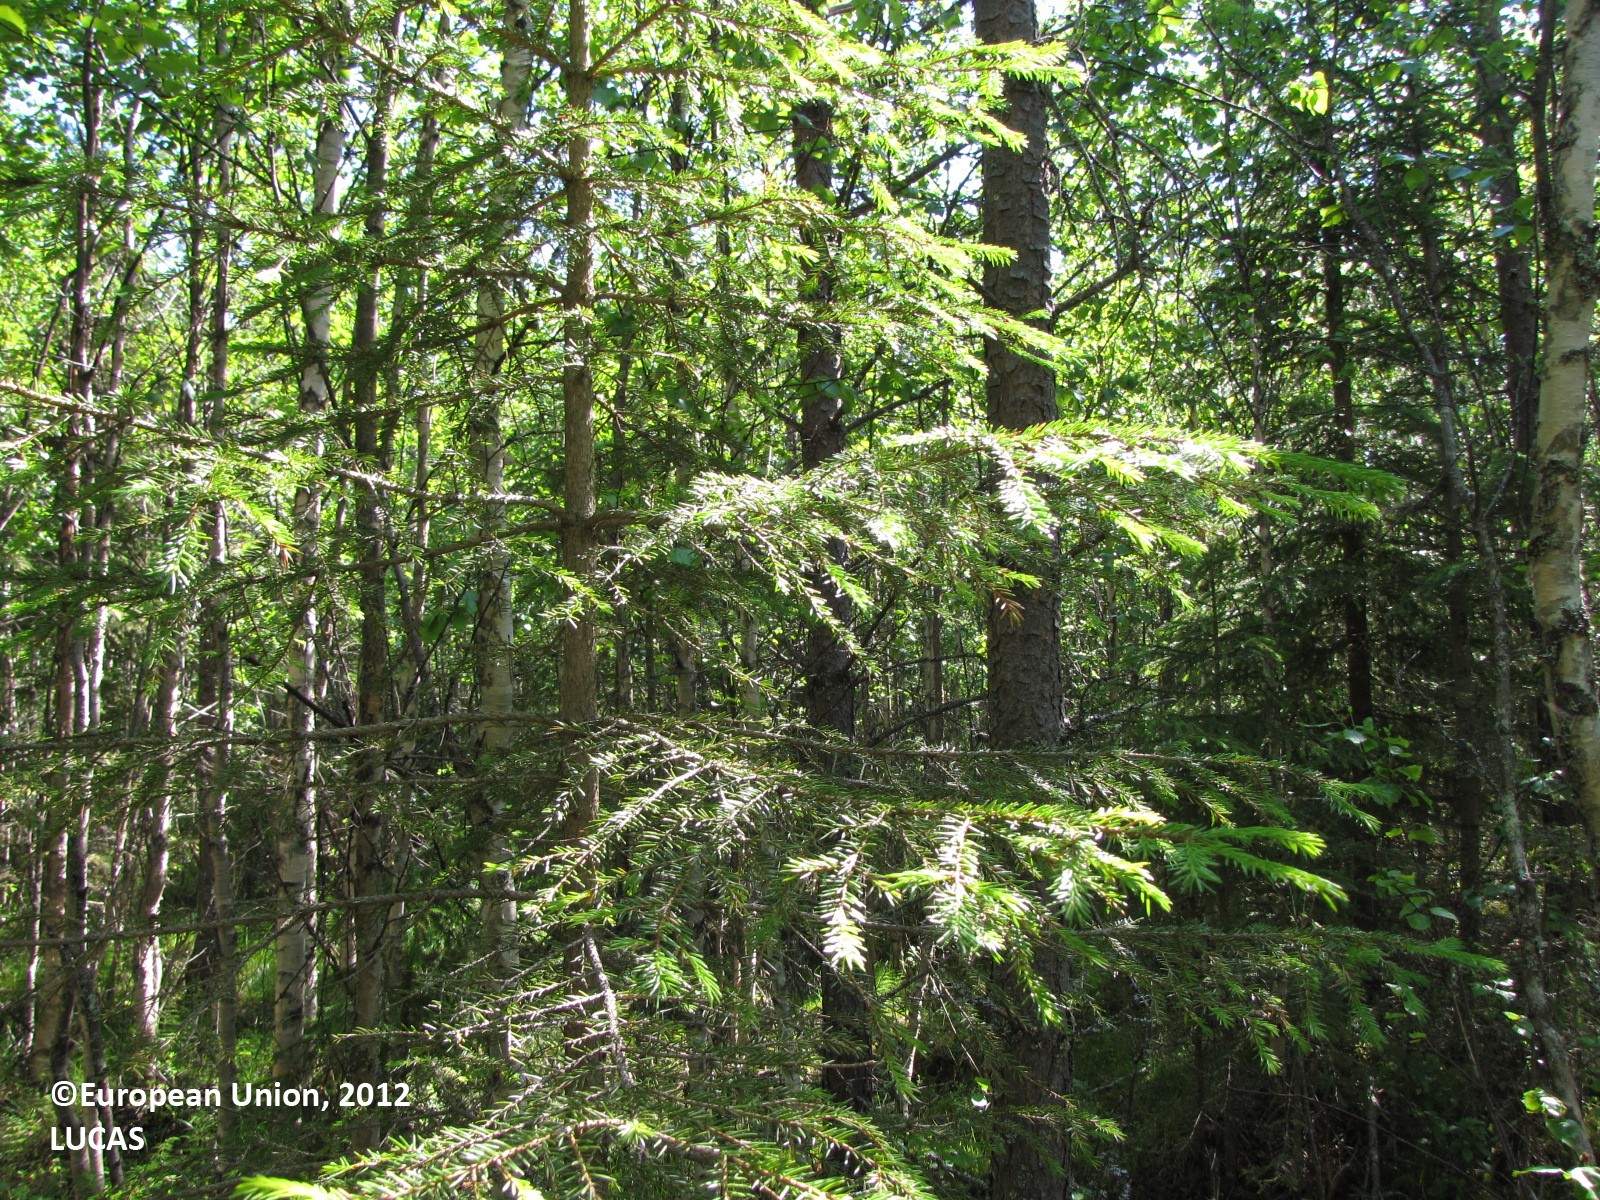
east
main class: Woodland
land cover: Other mixed woodland
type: boreal forest
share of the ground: > 75 %
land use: Forestry
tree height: > 5 m
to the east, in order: Other mixed woodland; Broadleaved woodland; Grassland without tree/shrub cover; Railways; Grassland without tree/shrub cover; Ditches and canals; Lines of trees; Other mixed woodland; Grassland without tree/shrub cover; Ditches and canals; Grassland without tree/shrub cover; Broadleaved woodland
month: July
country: FI
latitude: 66.2922
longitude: 25.3309
